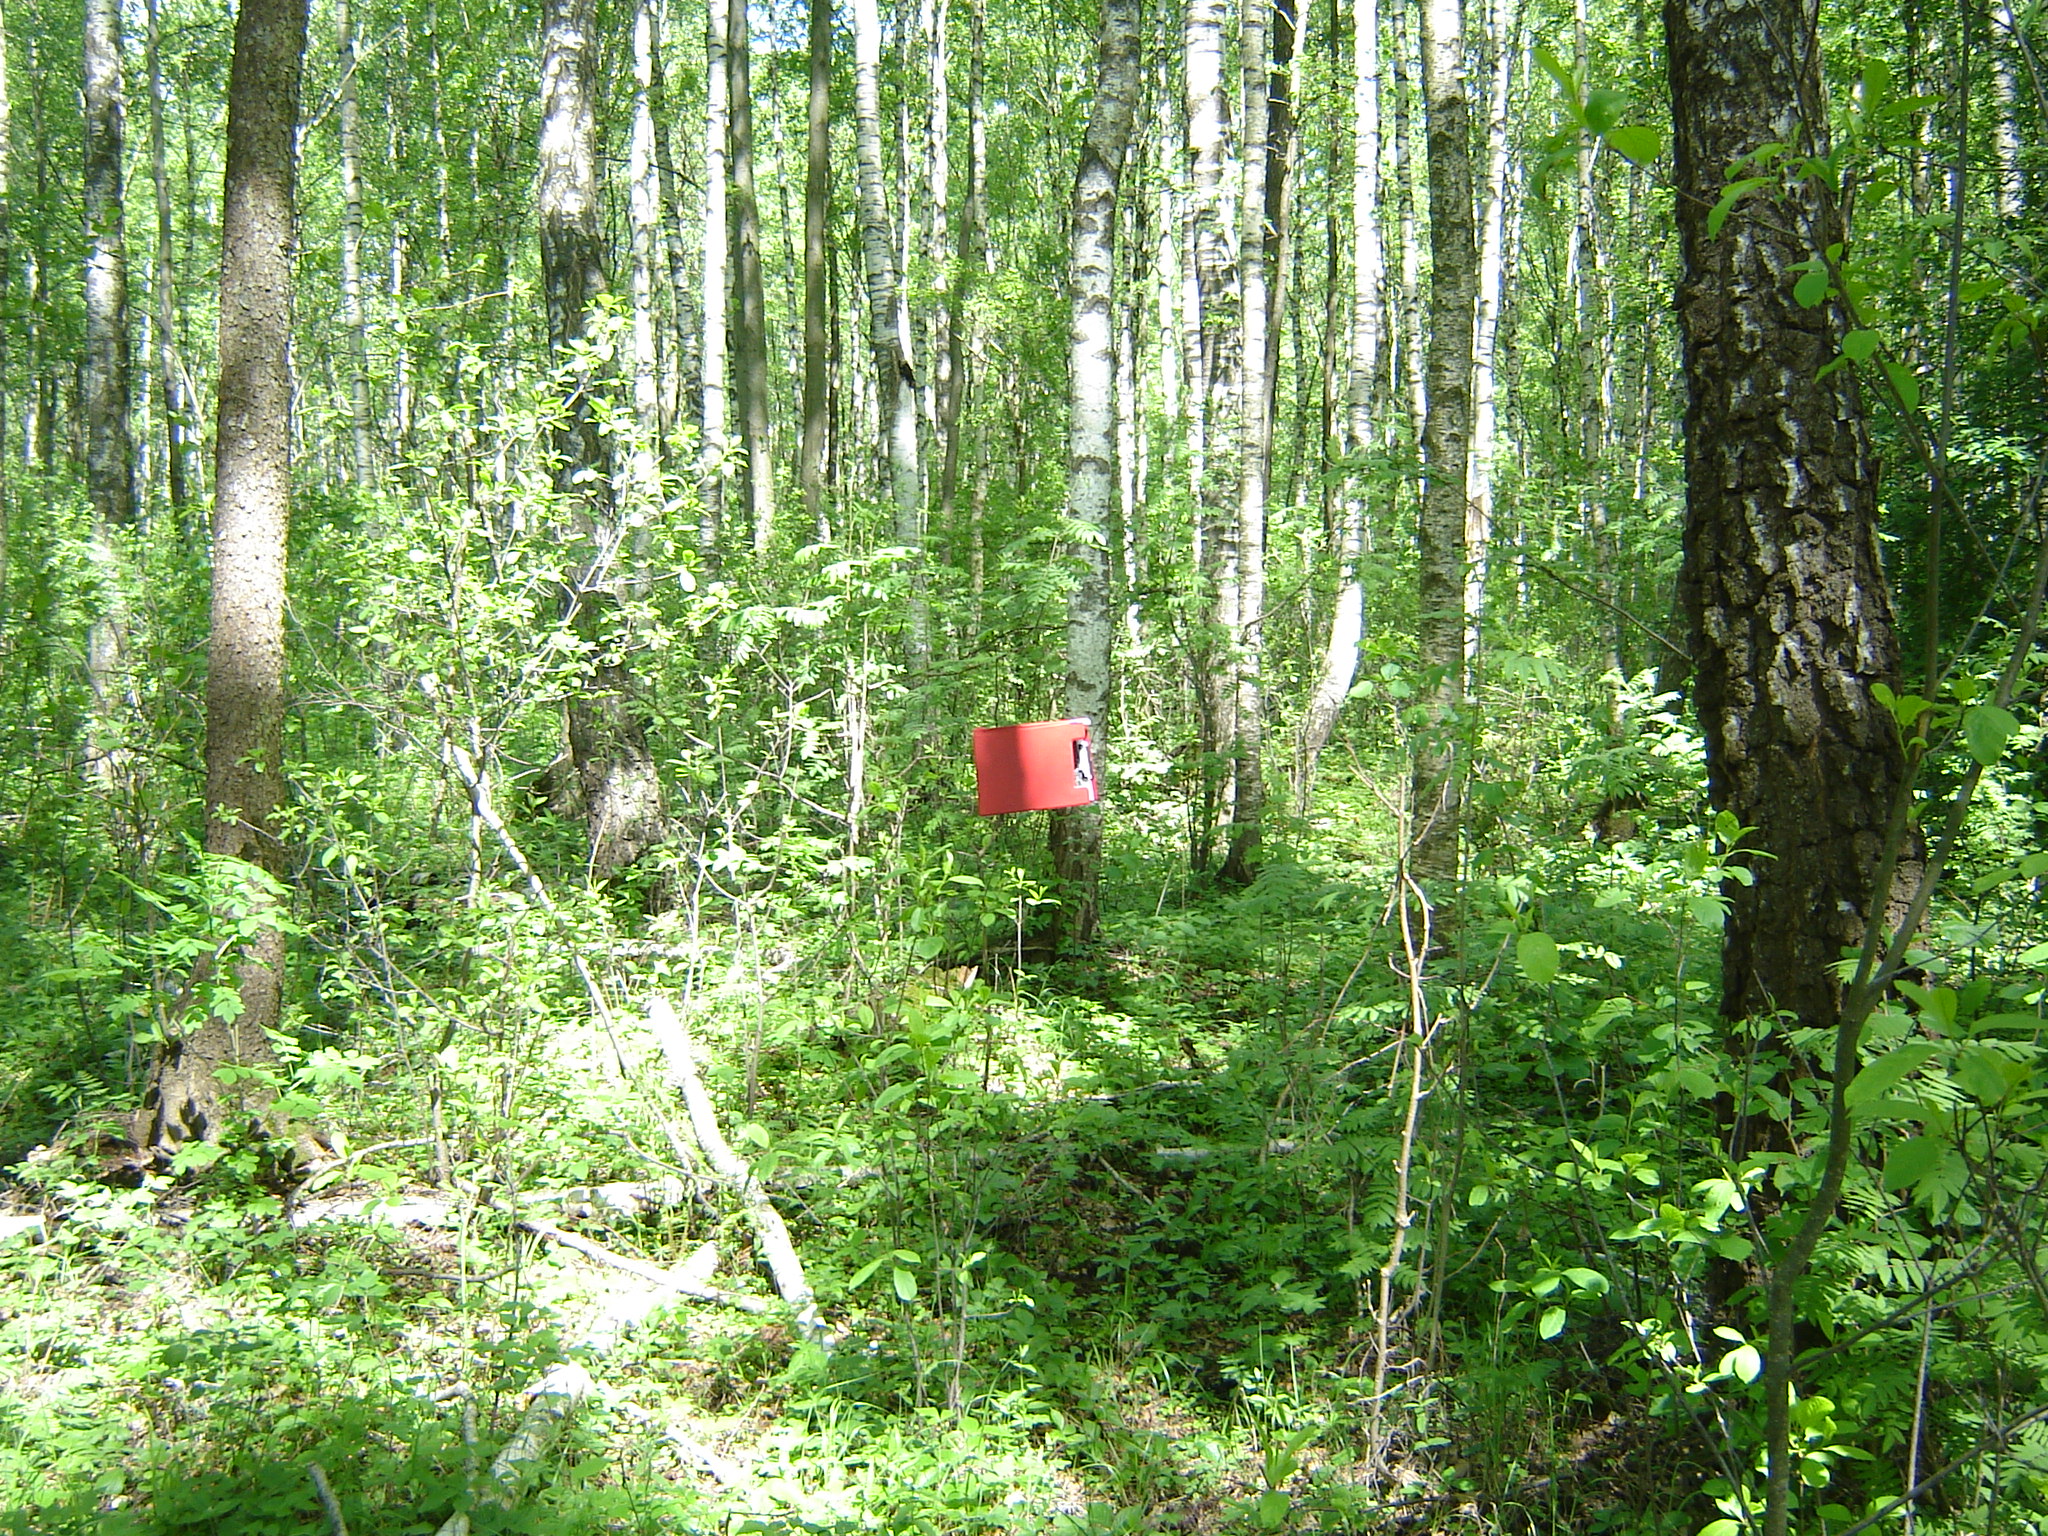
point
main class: Woodland
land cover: Broadleaved woodland
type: non-riverine alder, birch or aspen forest
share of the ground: > 75 %
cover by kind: broadleaved forest trees 95 %, herbaceous plants 5 %
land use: Forestry
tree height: > 5 m
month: May
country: LT
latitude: 55.8421
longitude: 25.2068
